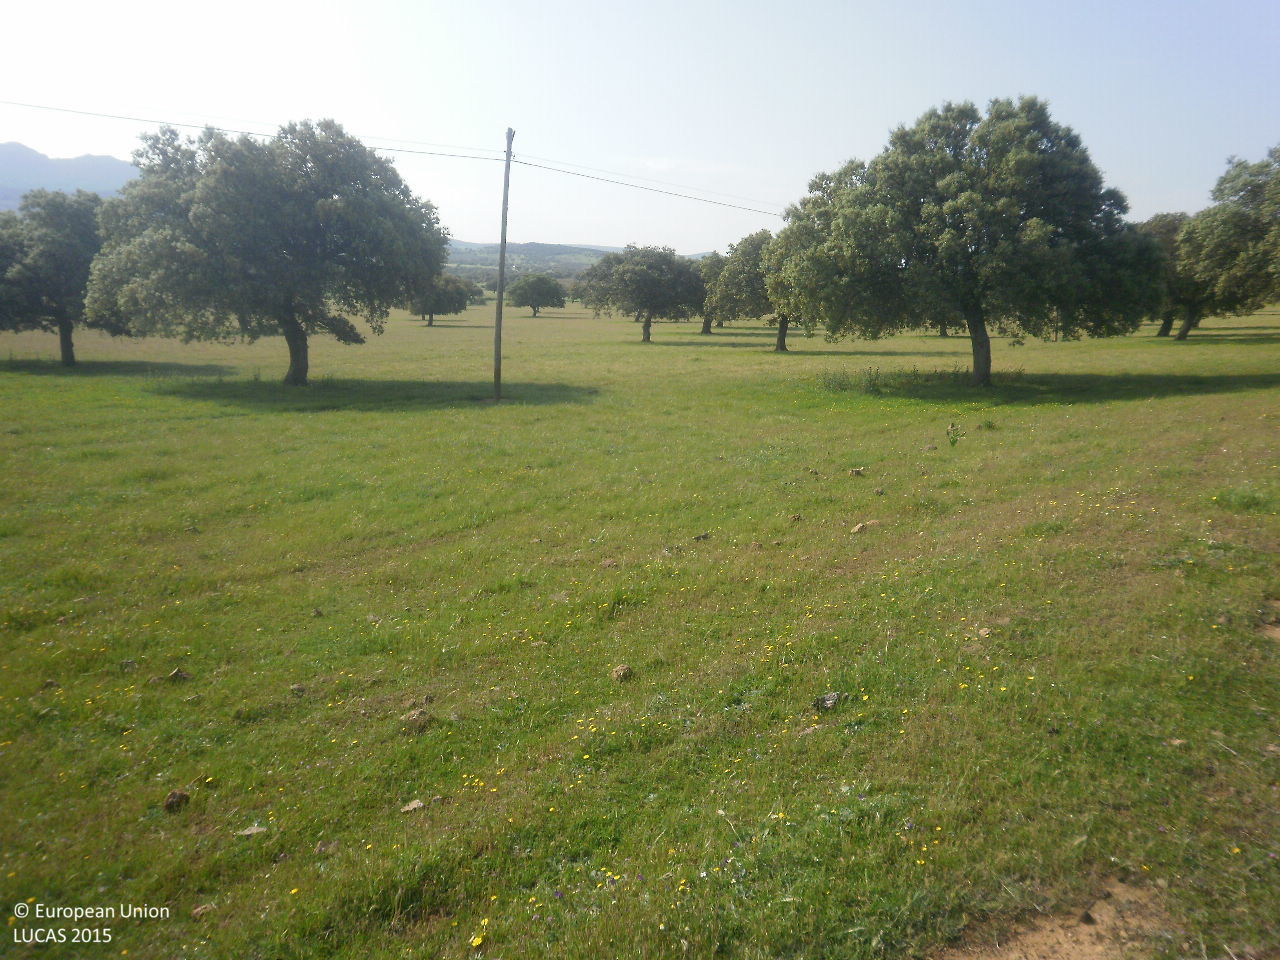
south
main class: Grassland
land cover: Grassland with sparse tree/shrub cover
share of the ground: > 75 %
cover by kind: herbaceous plants 90 %, broadleaved forest trees 5 %, shrubs 5 %
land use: Agriculture (excluding fallow land and kitchen gardens)
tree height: > 5 m
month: April
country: ES
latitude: 38.7641
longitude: -5.1916
